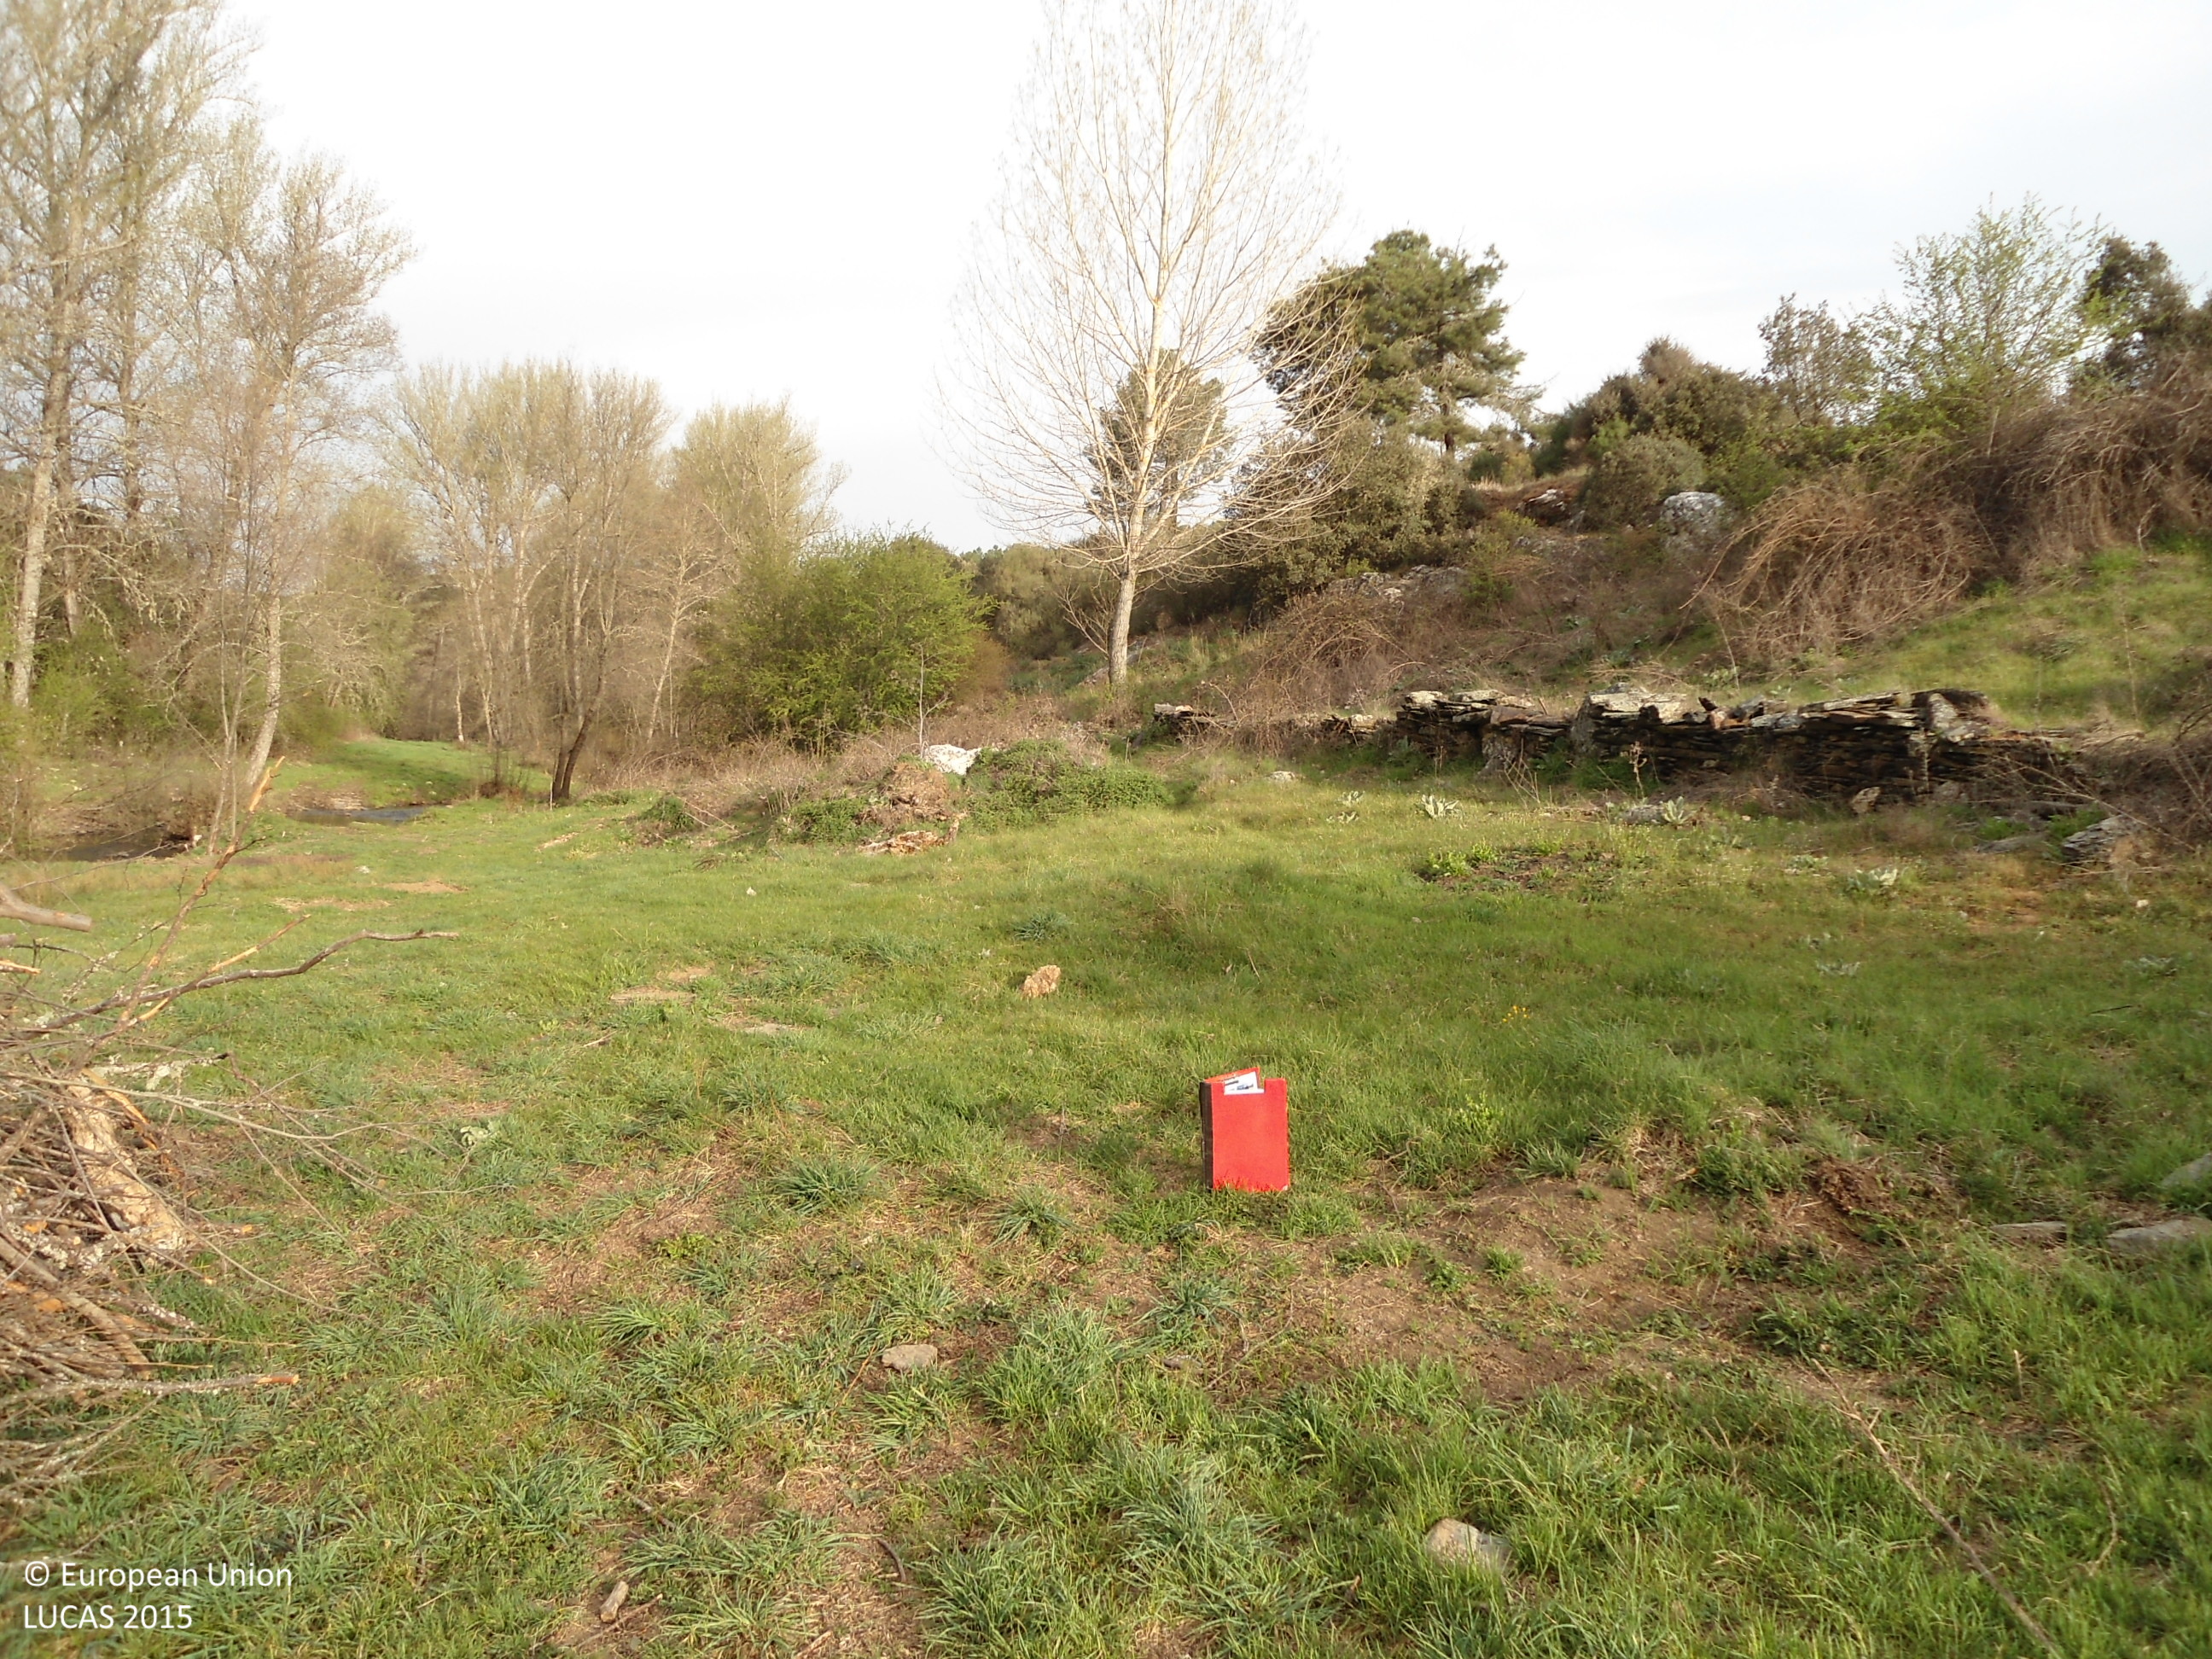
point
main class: Grassland
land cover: Grassland without tree/shrub cover
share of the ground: > 75 %
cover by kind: herbaceous plants 100 %
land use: Agriculture (excluding fallow land and kitchen gardens)
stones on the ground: < 10 %
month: April
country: ES
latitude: 41.7150
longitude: -6.4879
